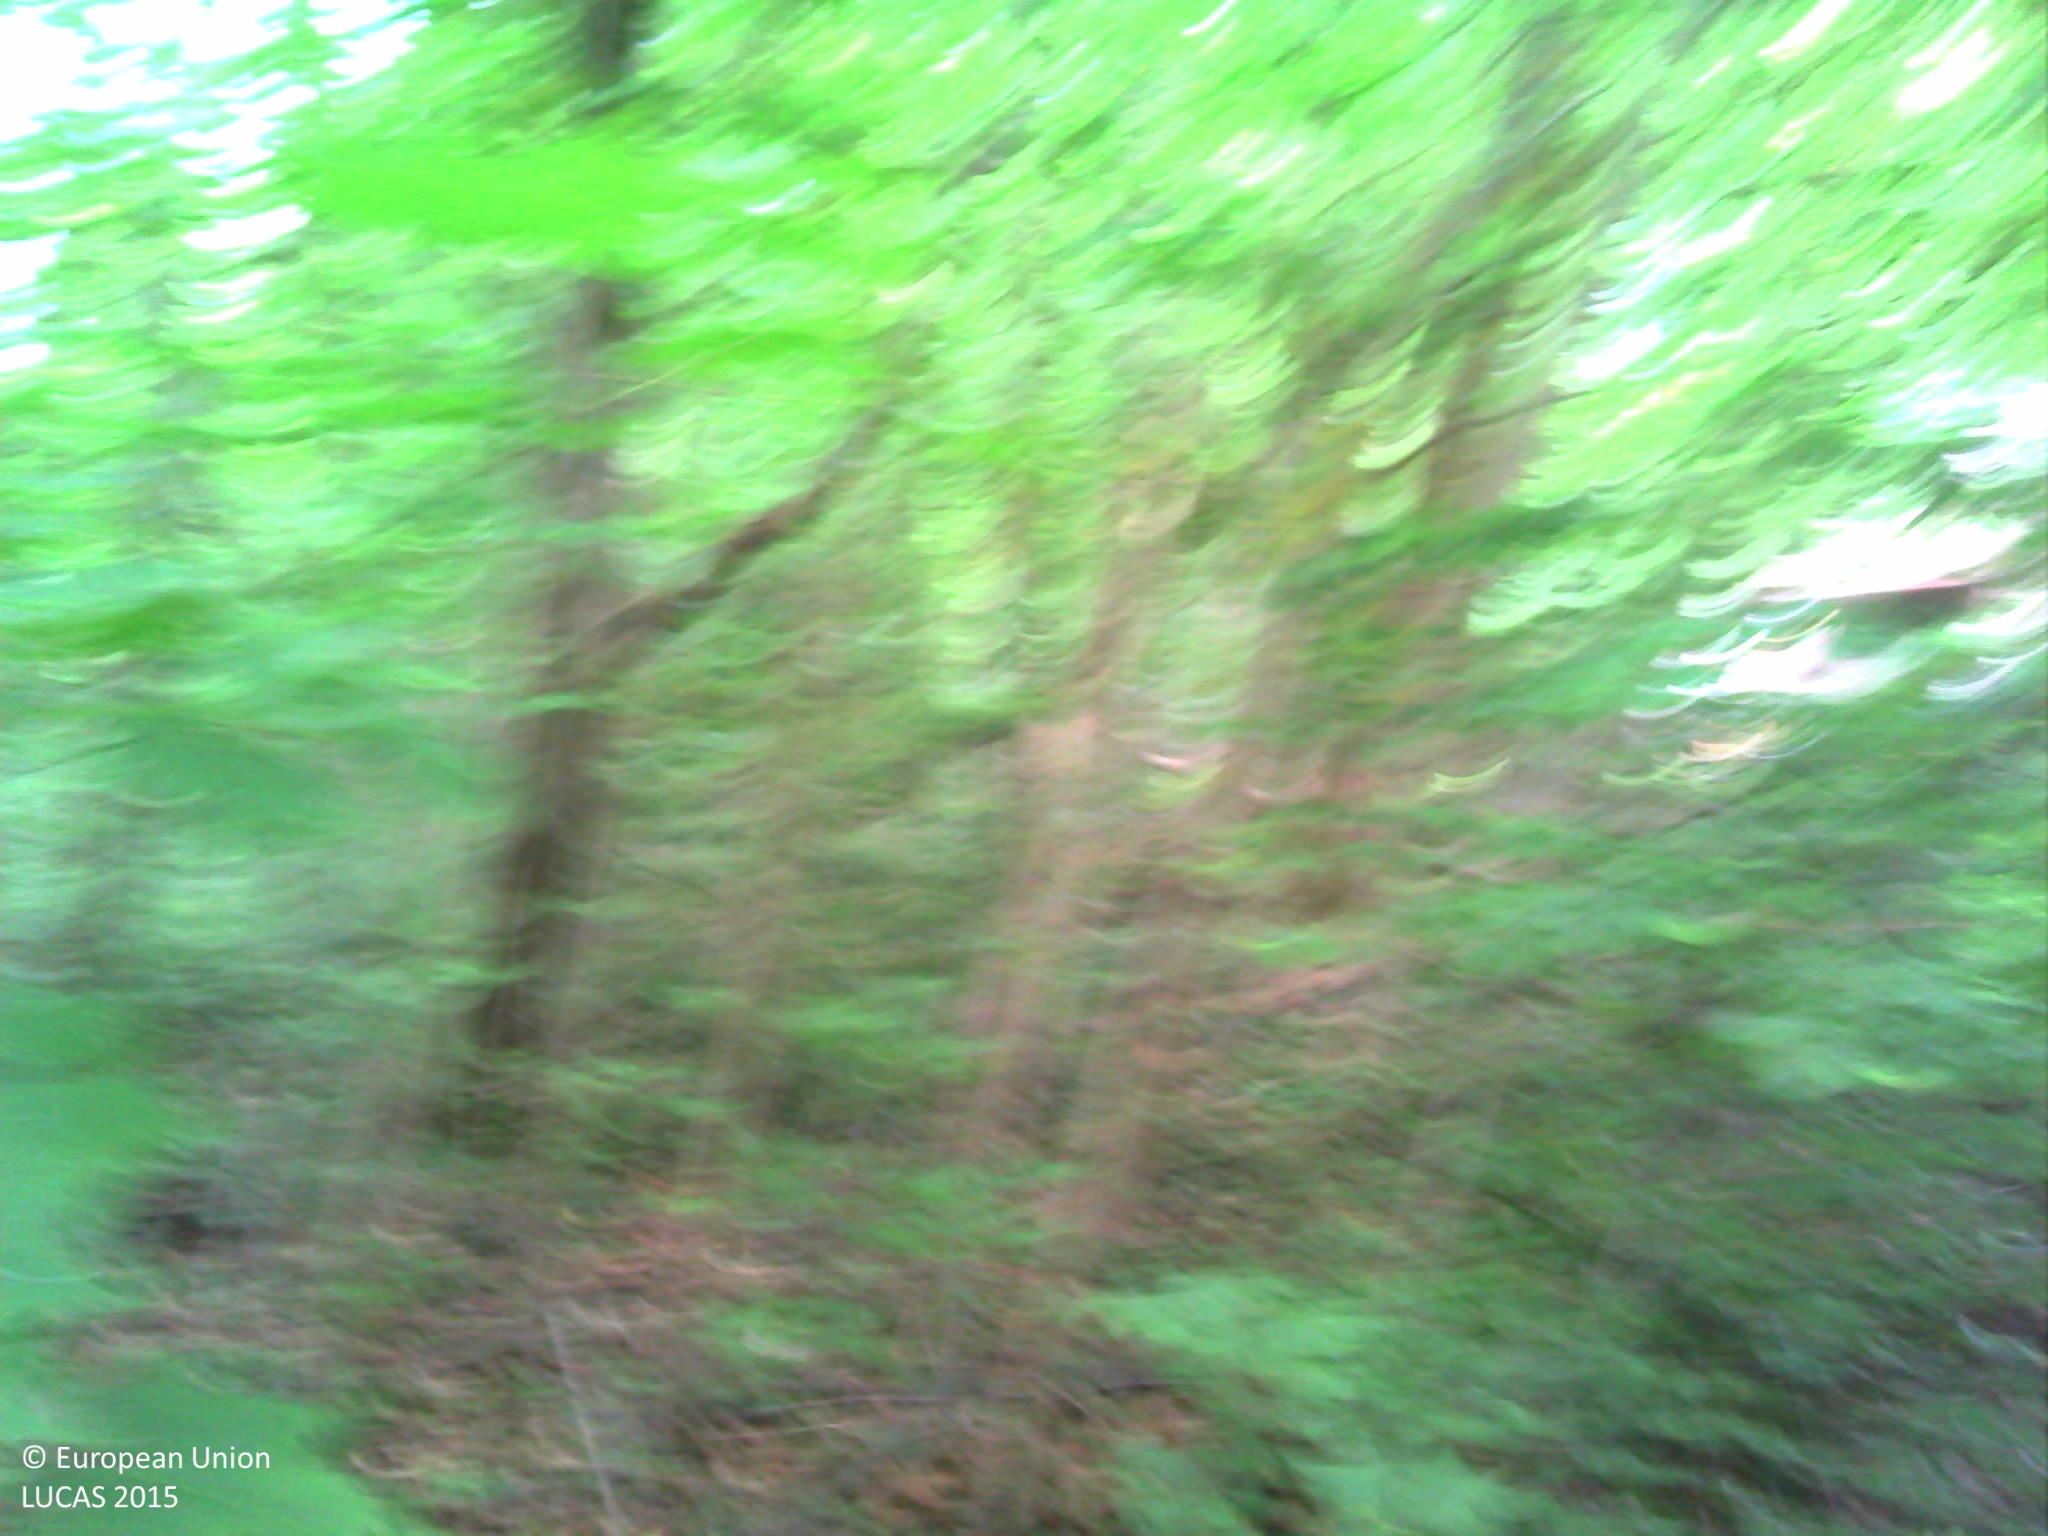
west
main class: Woodland
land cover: Broadleaved woodland
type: beech forest
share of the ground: > 75 %
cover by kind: broadleaved forest trees 100 %
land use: Forestry
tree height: > 5 m
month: May
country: BE
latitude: 50.6819
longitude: 4.4903
